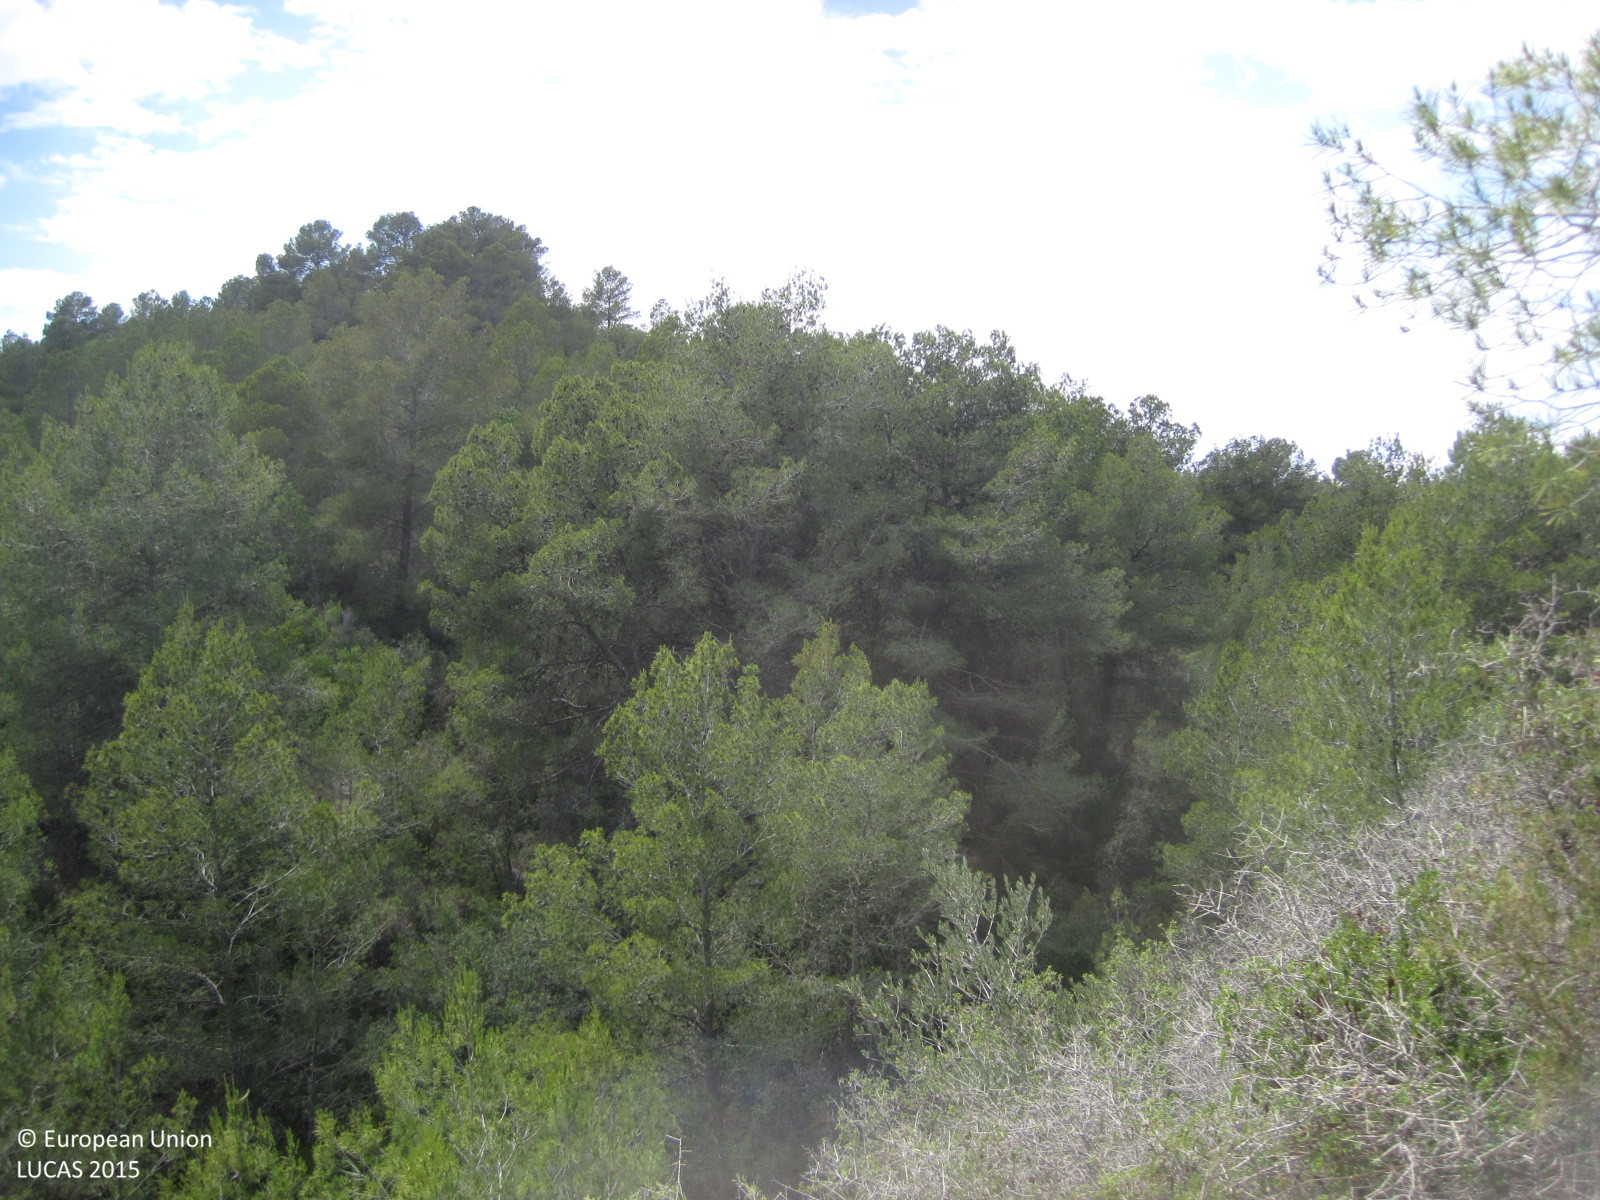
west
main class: Woodland
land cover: Pine dominated coniferous woodland
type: coniferous forest of the mediterranean region
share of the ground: 25 - 50 %
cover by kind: shrubs 40 %, coniferous forest trees 35 %, herbaceous plants 20 %, consolidated bare surface 5 %
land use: Semi-natural and natural areas not in use
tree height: > 5 m
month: June
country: ES
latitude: 39.2717
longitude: -0.6021
